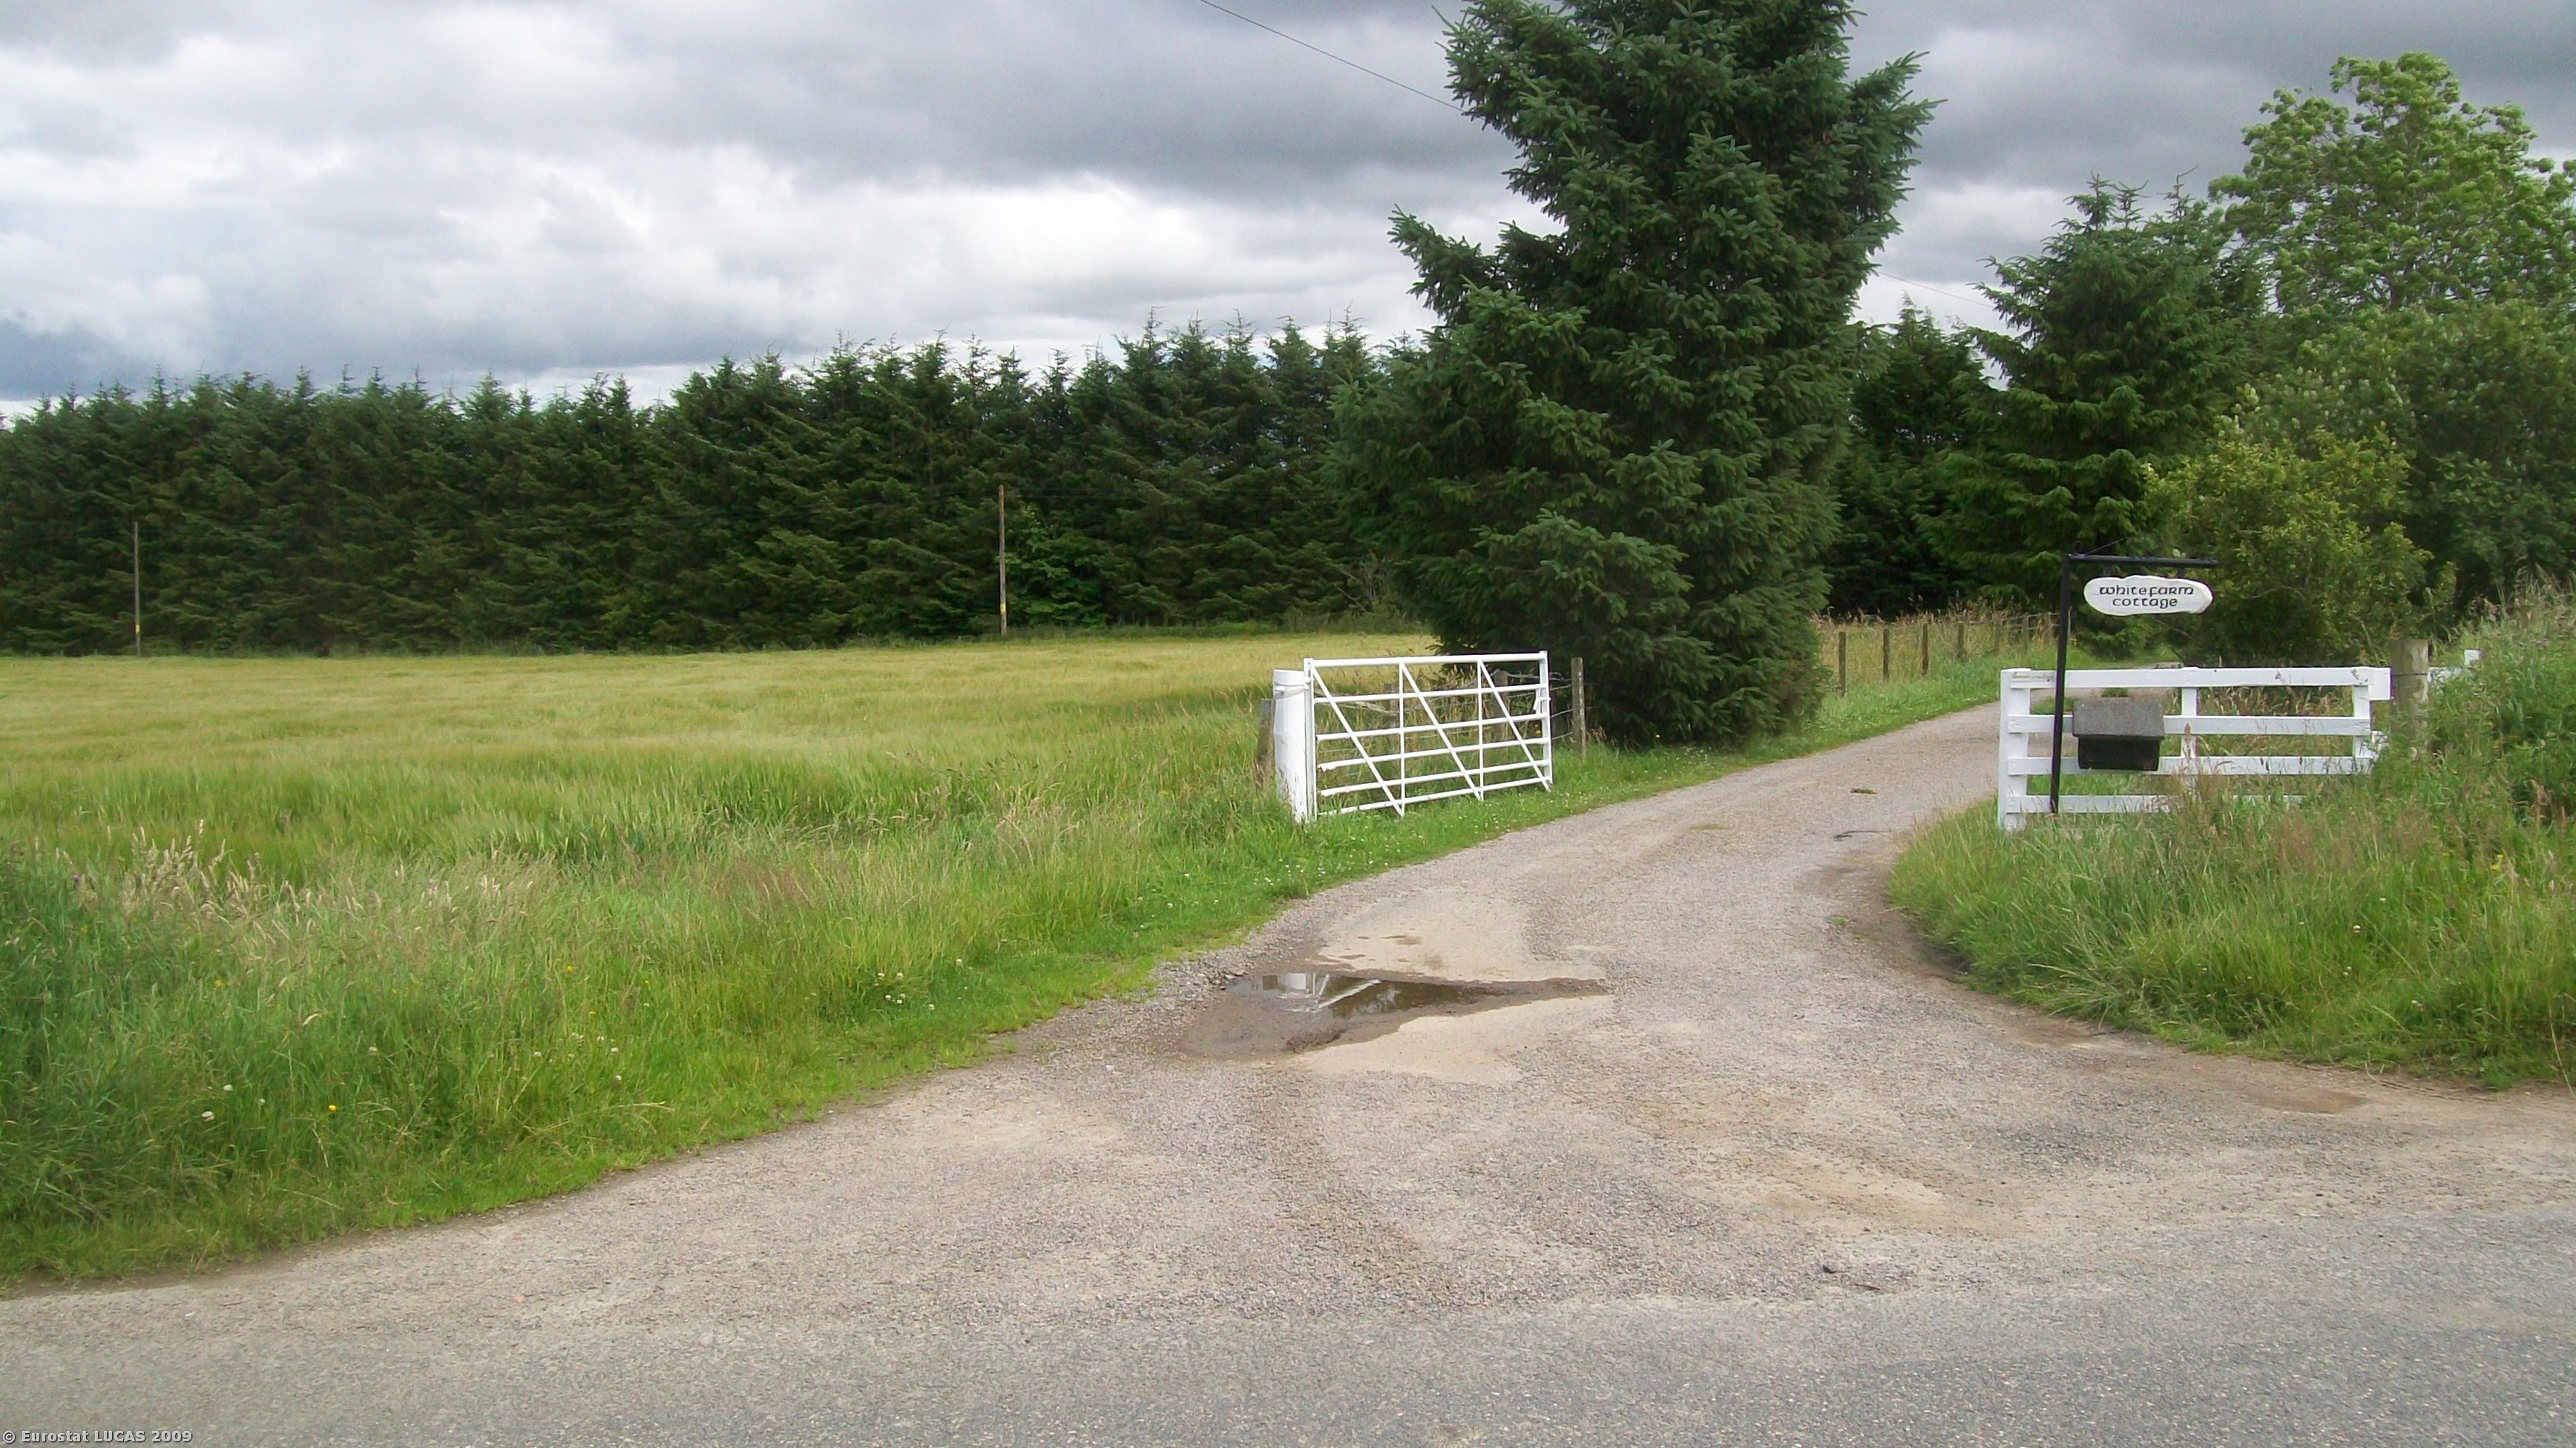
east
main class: Cropland
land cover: Barley
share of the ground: > 75 %
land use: Agriculture (excluding fallow land and kitchen gardens)
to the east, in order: Barley; Grass margins; Fences; Shrubland without tree cover; Grass margins; Paved roads, cycling and walking lanes; Grass margins; Fences; Electric lines; Grass margins; Barley; Grass margins; Electric lines; Grass margins; Ditches and canals; Coniferous woodland; Fences; Artificial constructions in urban areas
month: July
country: GB
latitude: 57.4090
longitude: -2.5551
